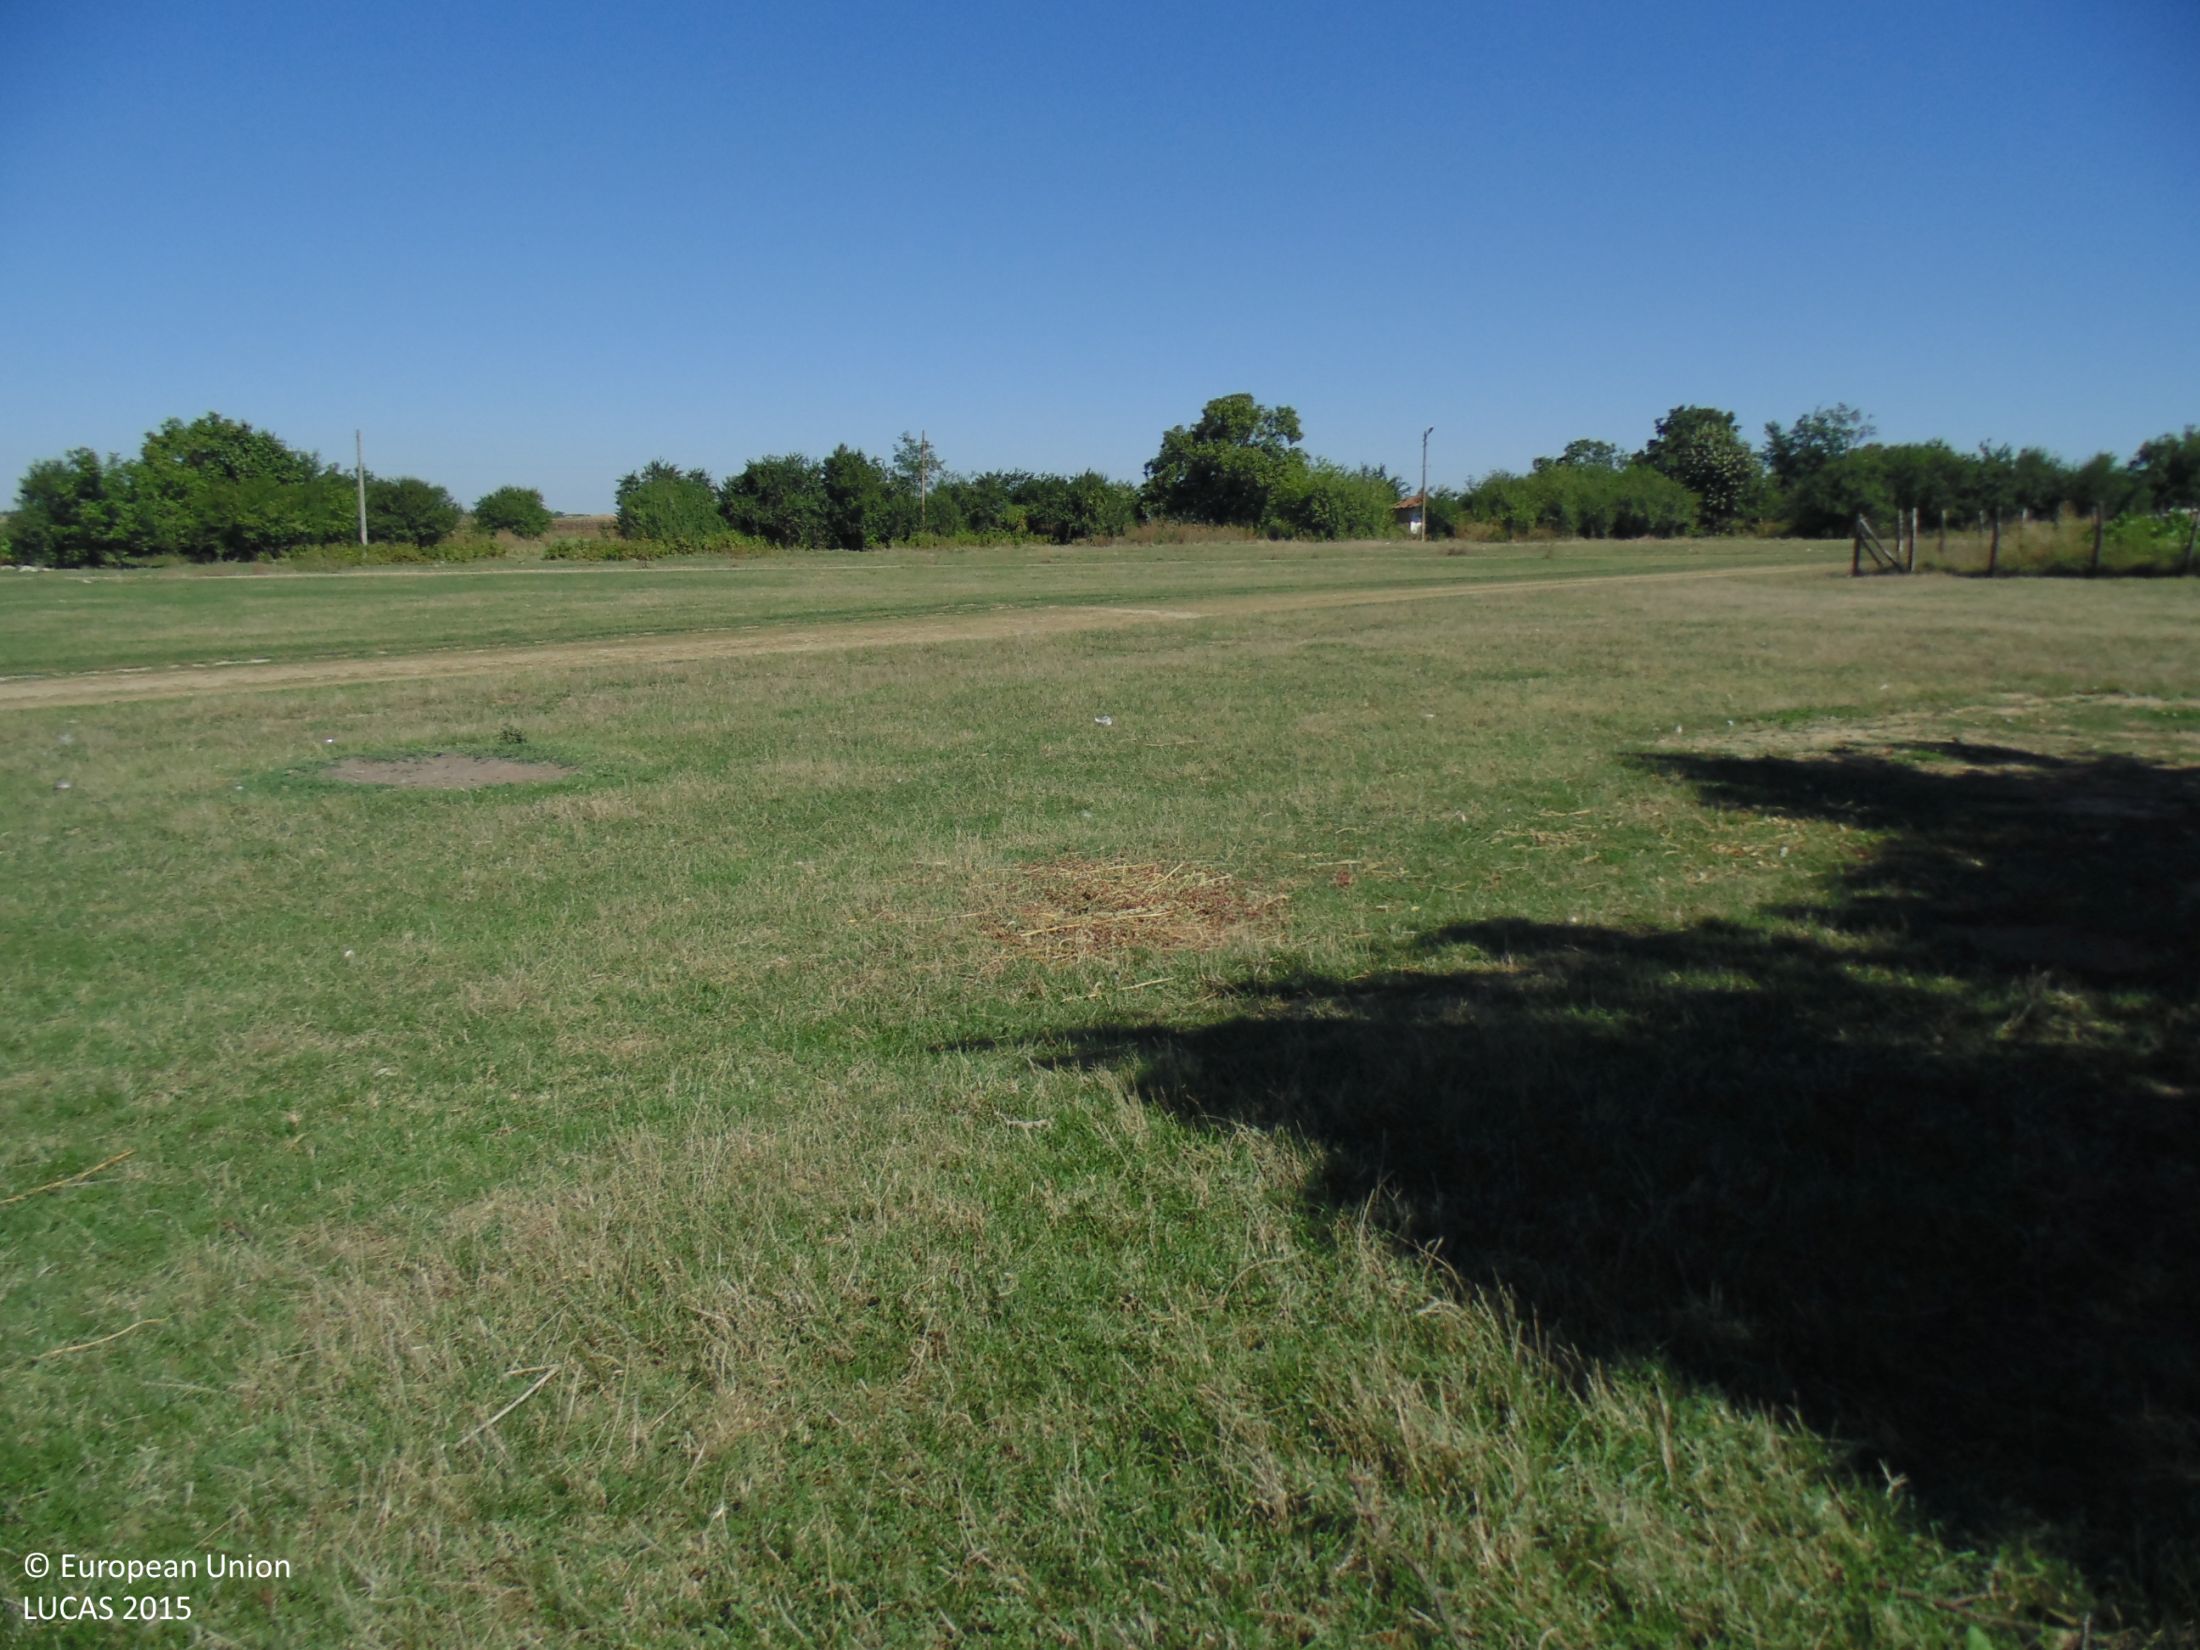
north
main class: Grassland
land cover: Grassland with sparse tree/shrub cover
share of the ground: > 75 %
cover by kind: herbaceous plants 90 %, broadleaved forest trees 5 %, shrubs 5 %
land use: Residential
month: September
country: BG
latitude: 43.8168
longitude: 27.1199
